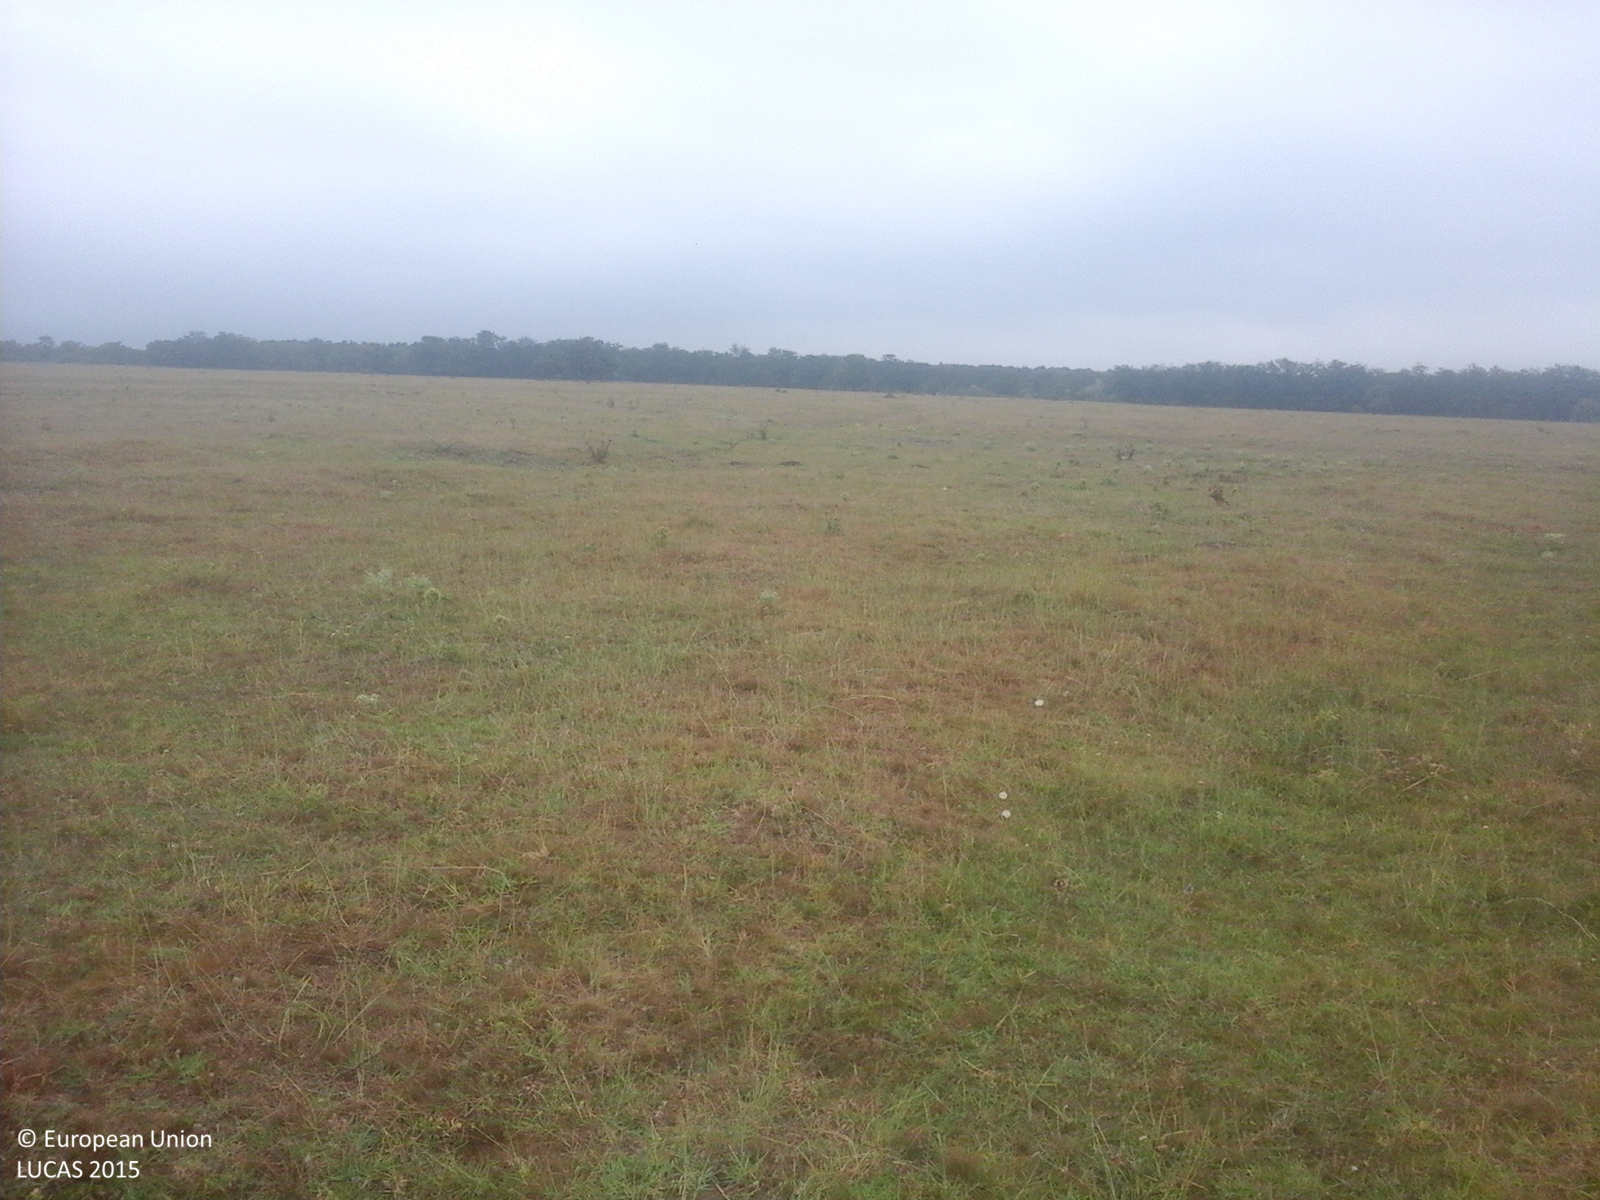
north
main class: Grassland
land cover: Grassland without tree/shrub cover
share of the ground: > 75 %
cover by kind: herbaceous plants 100 %
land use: Agriculture (excluding fallow land and kitchen gardens)
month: August
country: RO
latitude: 44.7680
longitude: 28.4323
